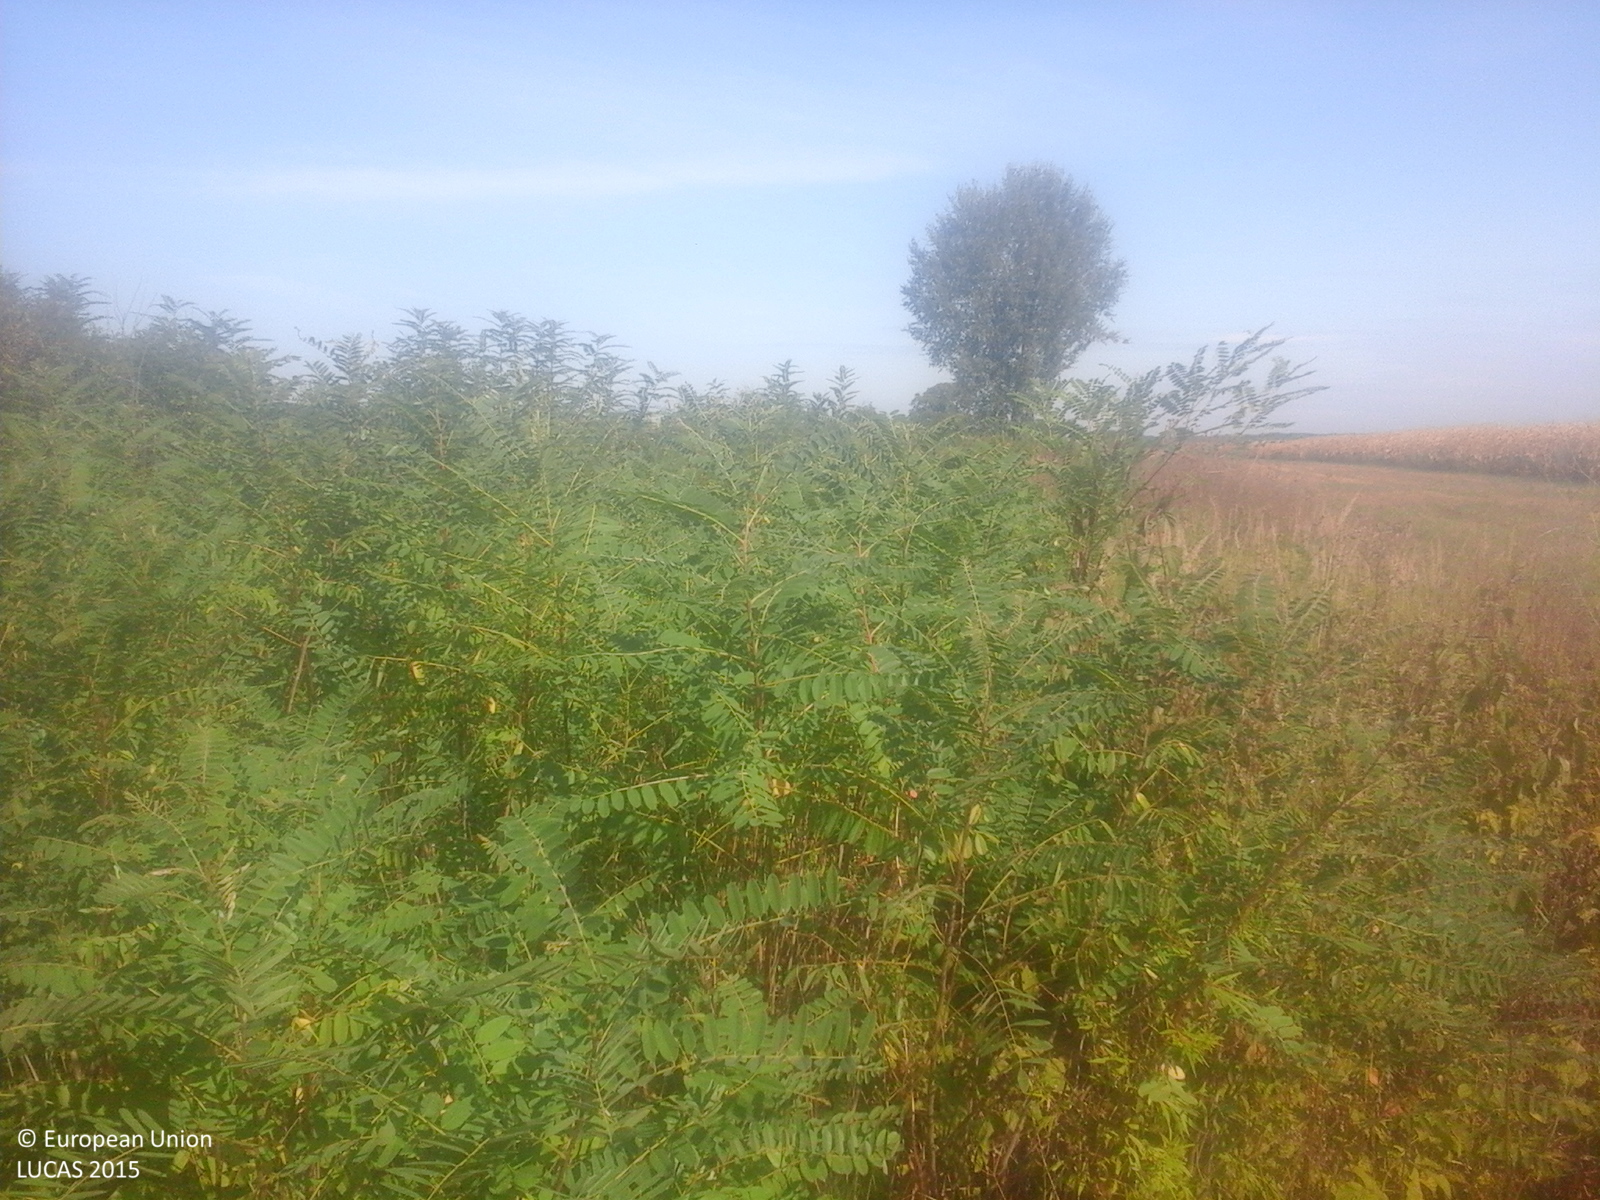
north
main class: Cropland
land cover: Maize
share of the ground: > 75 %
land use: Agriculture (excluding fallow land and kitchen gardens)
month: September
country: RO
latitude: 47.7999
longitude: 22.8140
